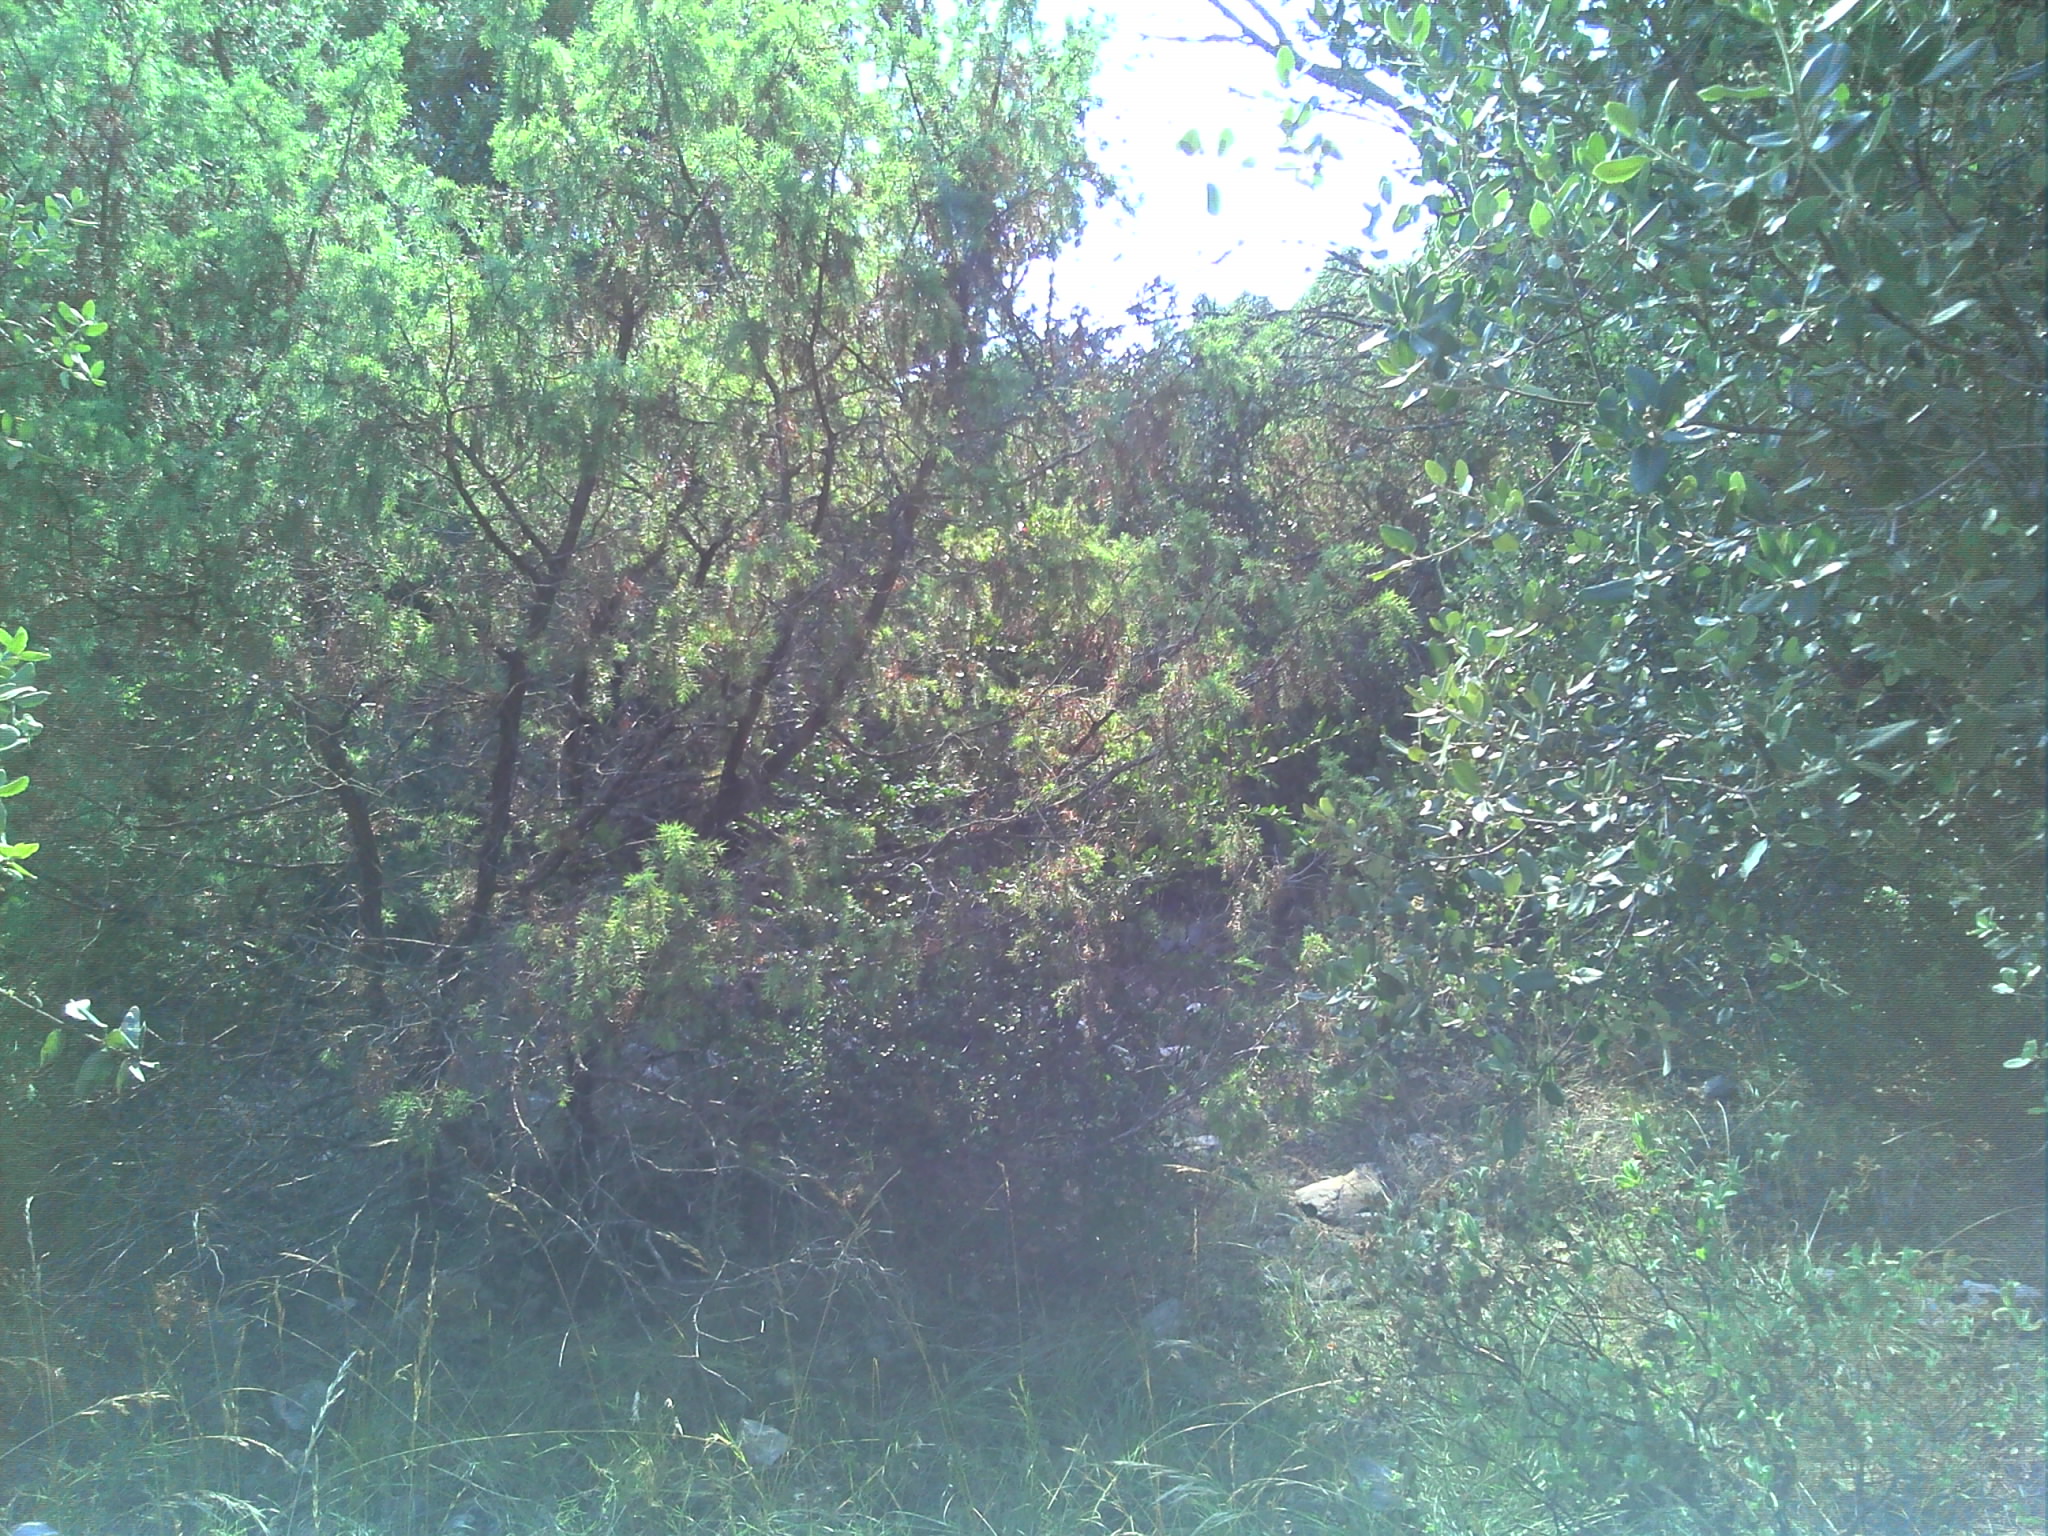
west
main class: Woodland
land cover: Pine dominated mixed woodland
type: coniferous forest of the mediterranean region
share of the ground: > 75 %
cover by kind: broadleaved forest trees 40 %, coniferous forest trees 30 %, herbaceous plants 20 %, shrubs 5 %, consolidated bare surface 5 %
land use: Semi-natural and natural areas not in use
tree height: > 5 m
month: August
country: FR
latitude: 44.0308
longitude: 4.6305
